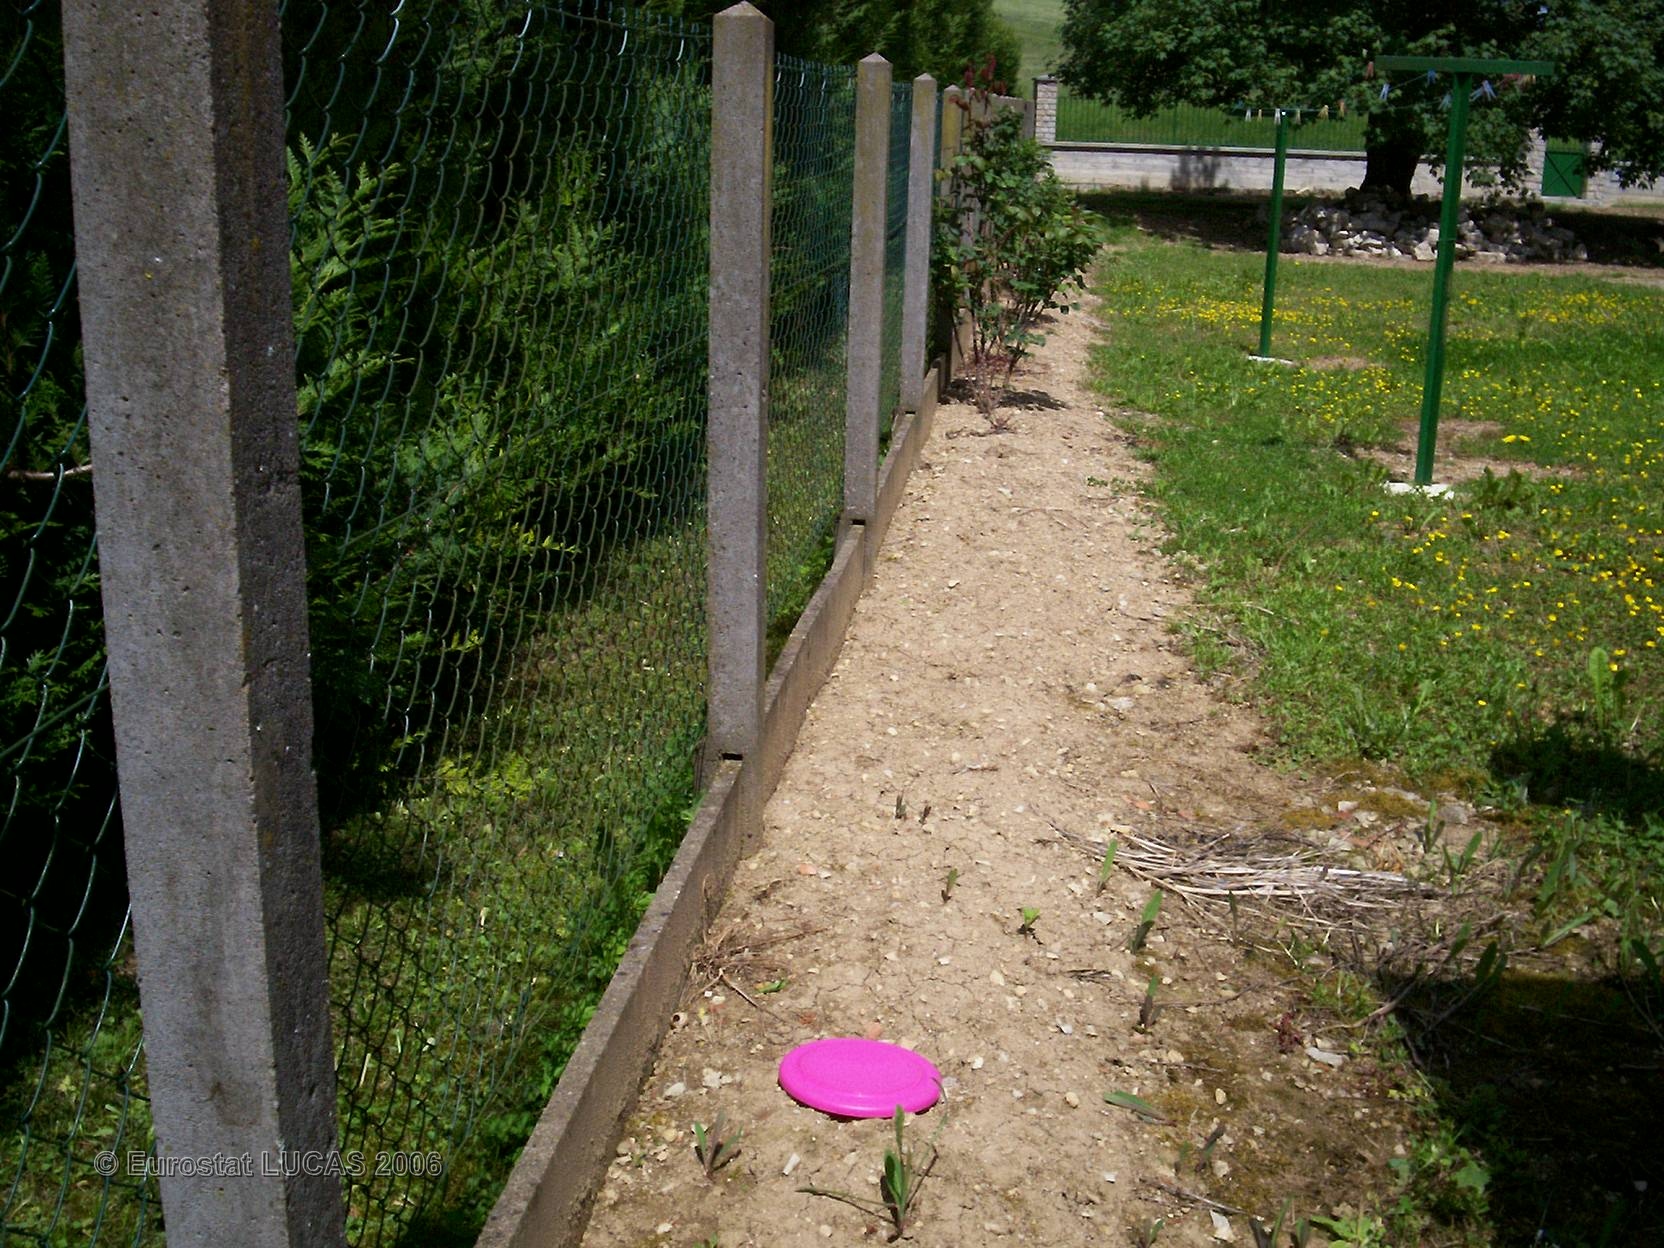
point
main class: Grassland
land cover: Grassland with sparse tree/shrub cover
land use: Residential
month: March
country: FR
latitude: 48.1431
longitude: 4.5548
